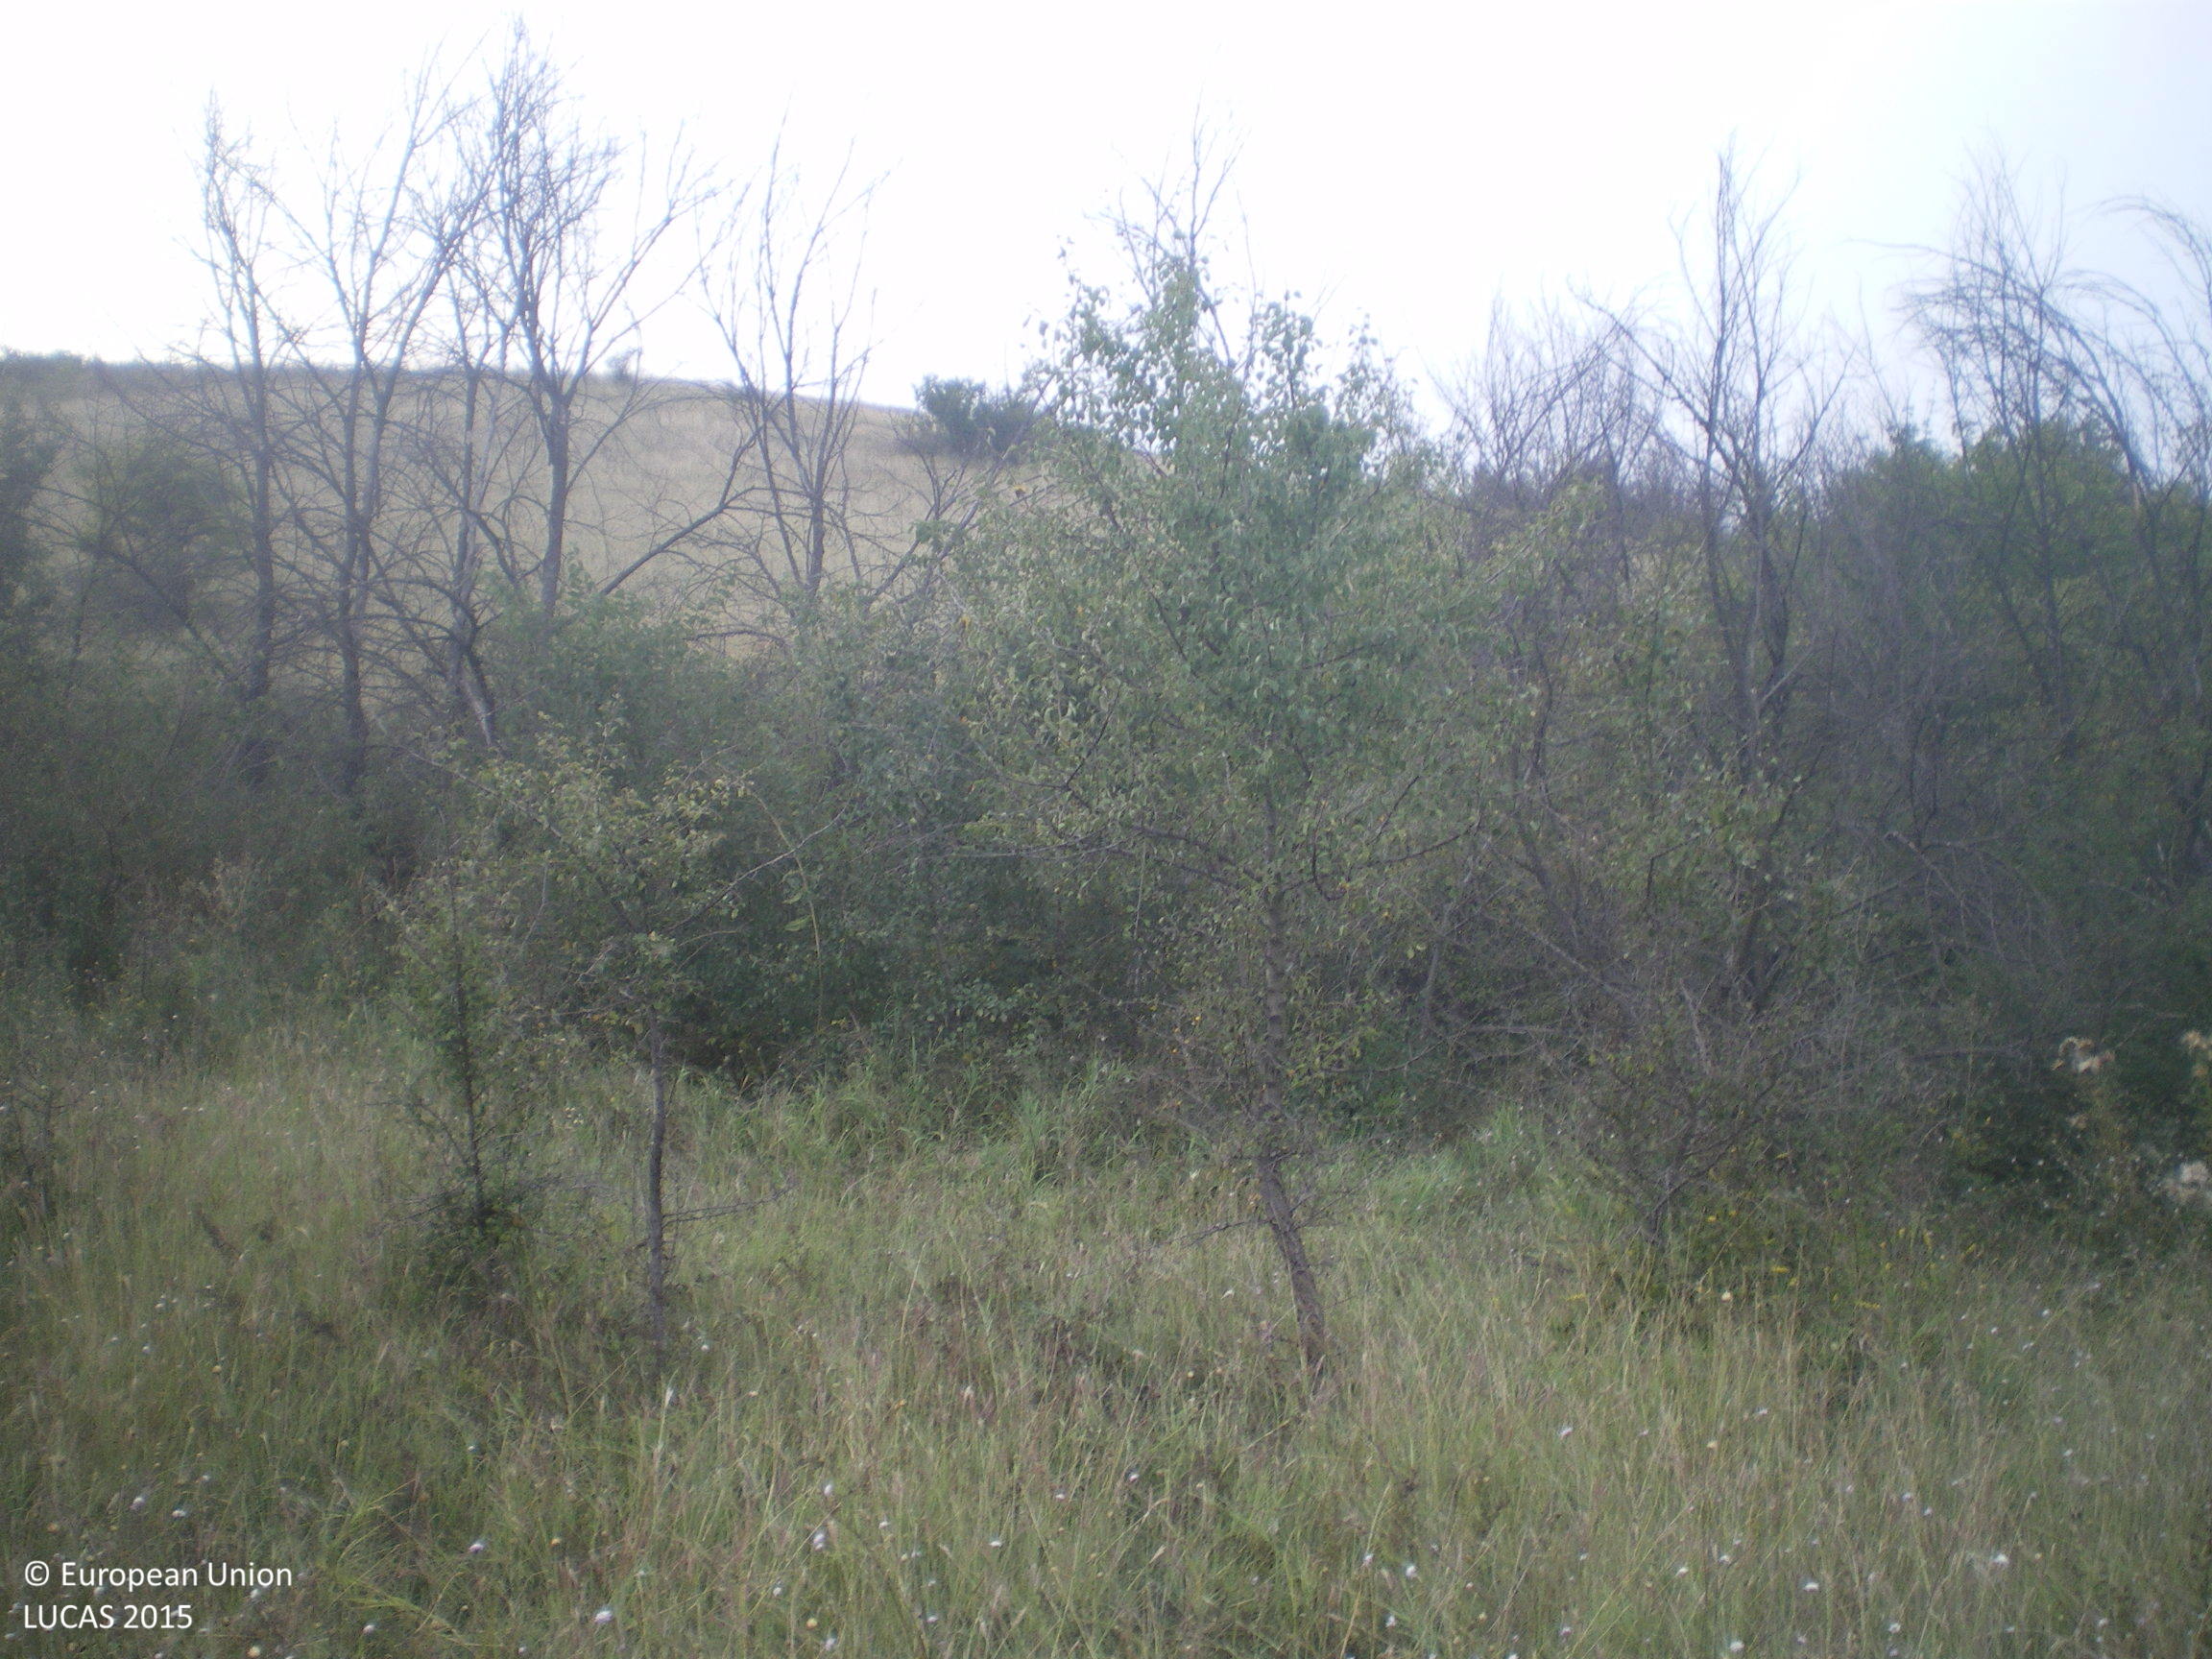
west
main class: Grassland
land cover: Grassland with sparse tree/shrub cover
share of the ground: > 75 %
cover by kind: herbaceous plants 90 %, broadleaved forest trees 5 %, shrubs 5 %
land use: Agriculture (excluding fallow land and kitchen gardens)
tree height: > 5 m
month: September
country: BG
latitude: 42.1323
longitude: 25.9598
